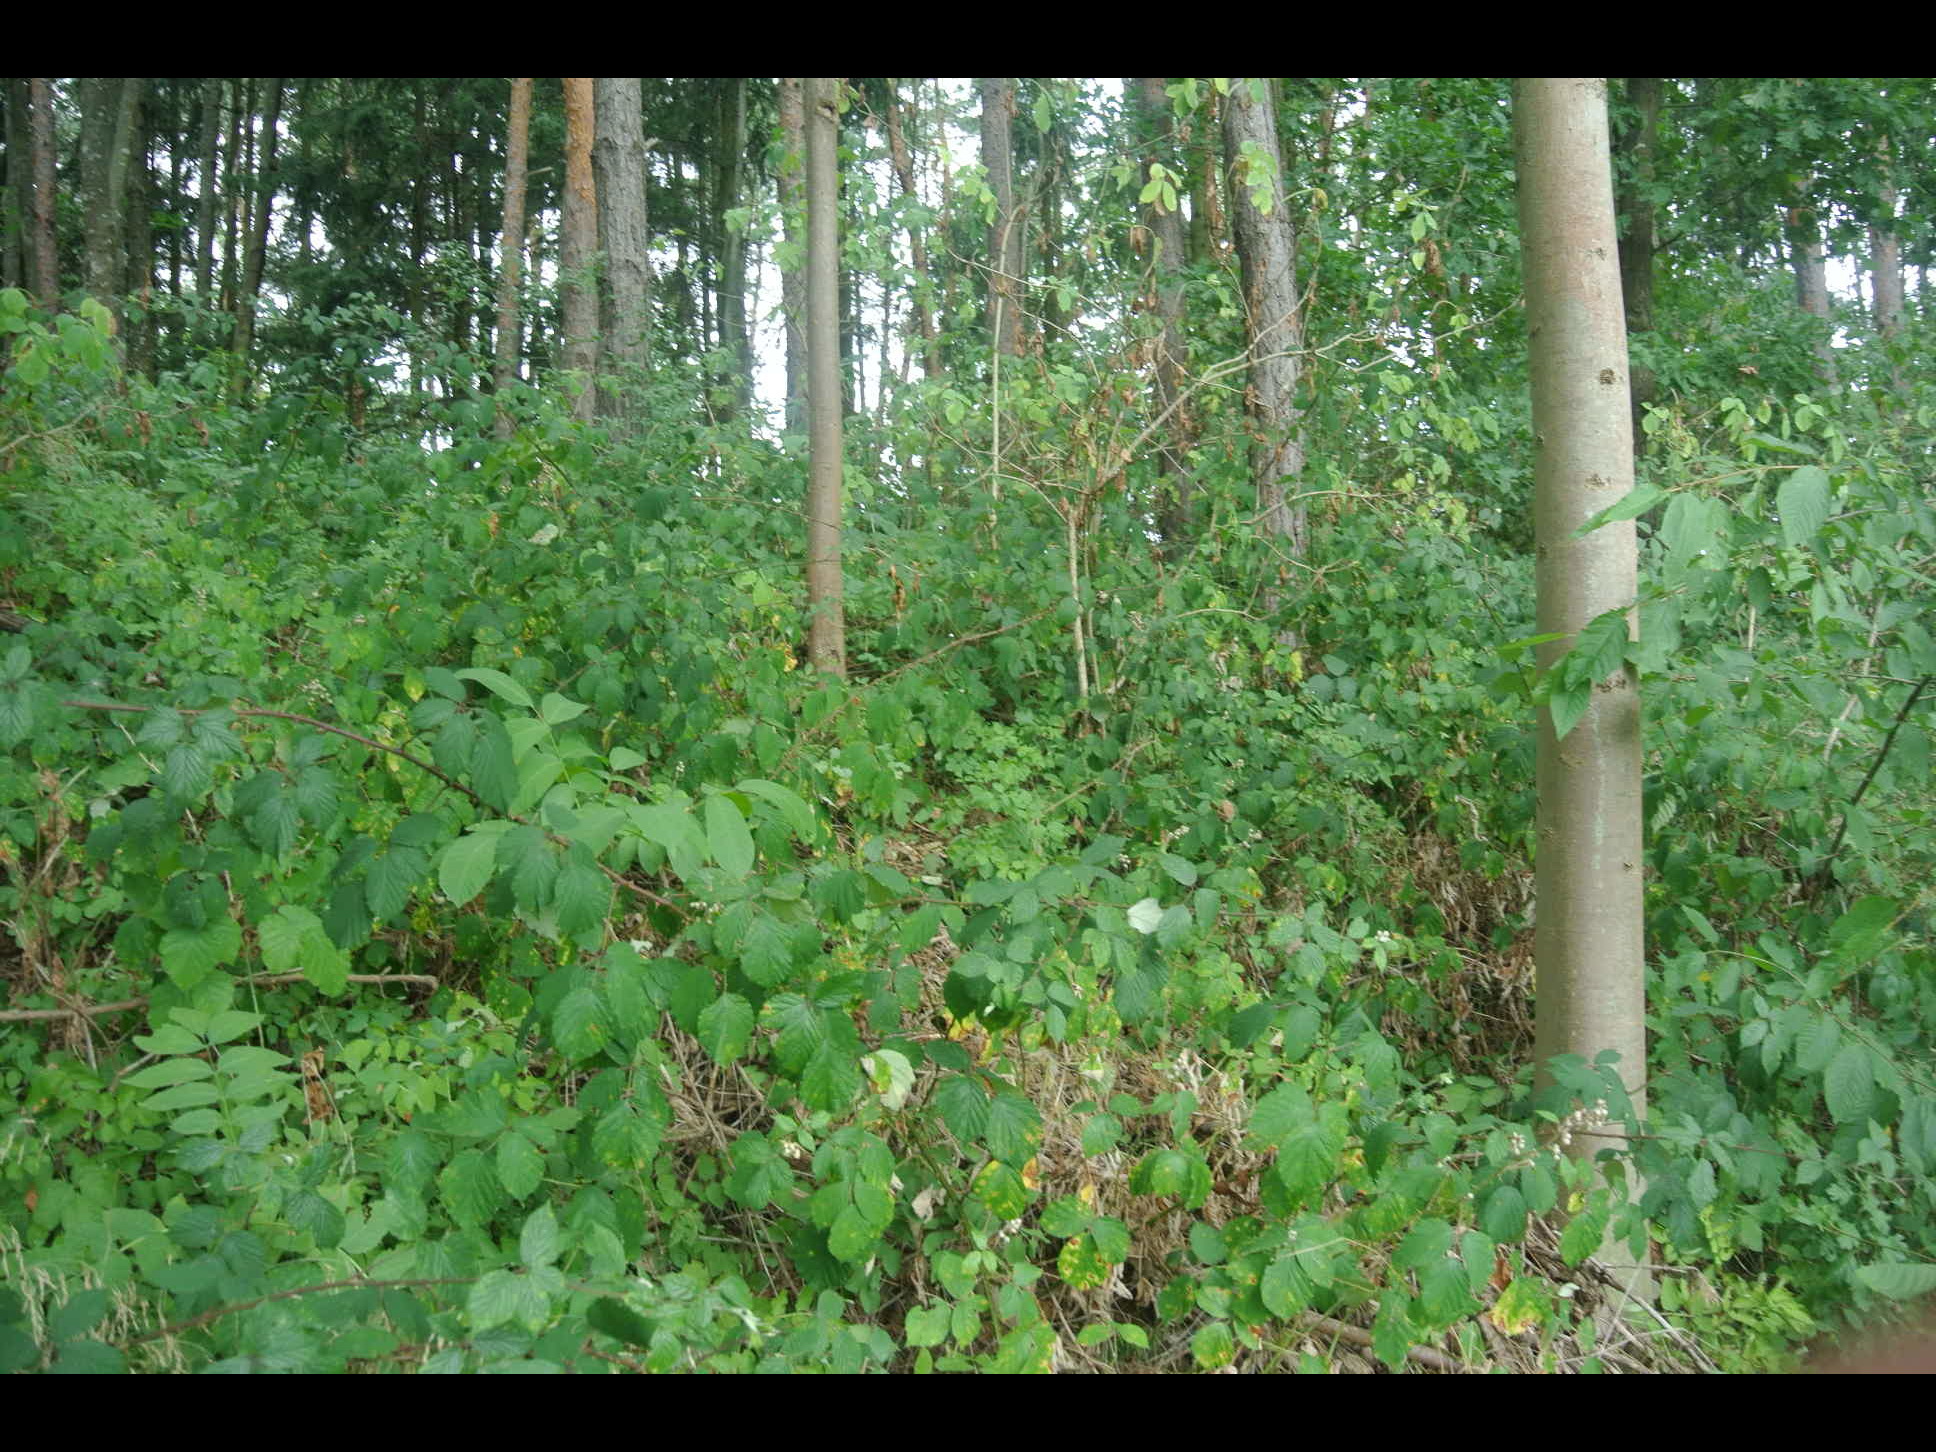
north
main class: Woodland
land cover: Pine dominated mixed woodland
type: alpine coniferous forest
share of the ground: > 75 %
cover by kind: broadleaved forest trees 65 %, coniferous forest trees 35 %
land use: Forestry
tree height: > 5 m
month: July
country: AT
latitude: 47.5325
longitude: 16.3928
